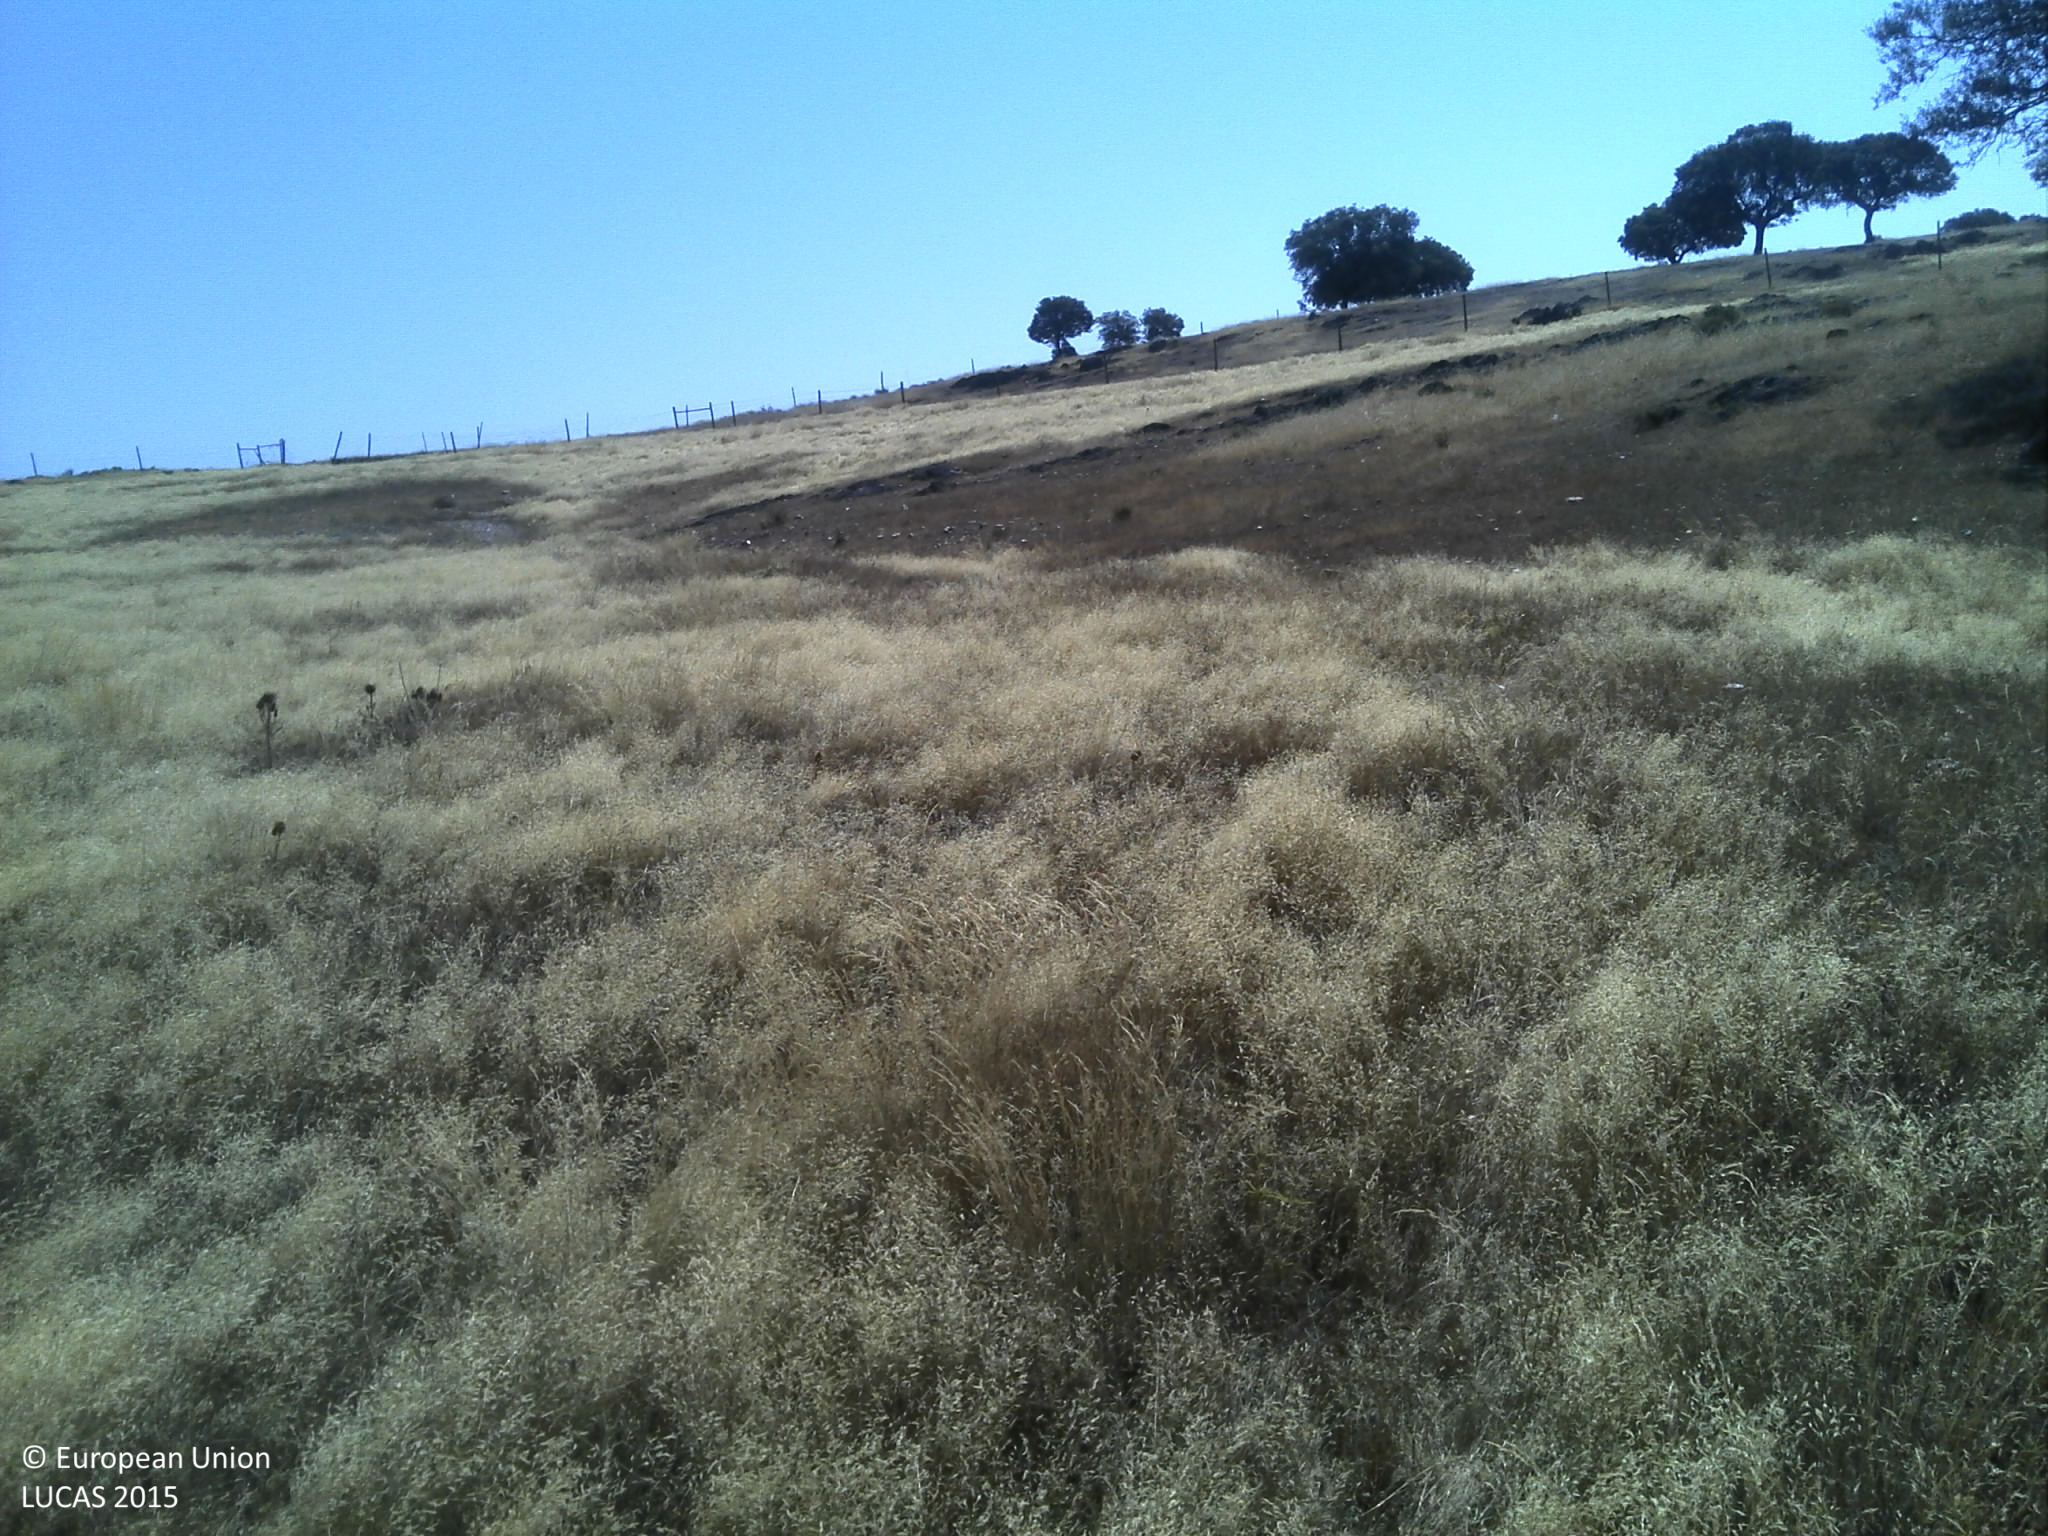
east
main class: Grassland
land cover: Grassland without tree/shrub cover
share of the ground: > 75 %
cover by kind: herbaceous plants 80 %, unconsolidated bare surface 10 %, shrubs 5 %
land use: Agriculture (excluding fallow land and kitchen gardens)
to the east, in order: Grassland without tree/shrub cover; Fences; Tracks; Rock outcrops; Grassland without tree/shrub cover; Rock outcrops; Grassland without tree/shrub cover; Broadleaved woodland; Fences; Grassland without tree/shrub cover; Tracks; Grassland with sparse tree/shrub cover; Broadleaved woodland
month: June
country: PT
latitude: 39.6803
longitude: -7.0739
